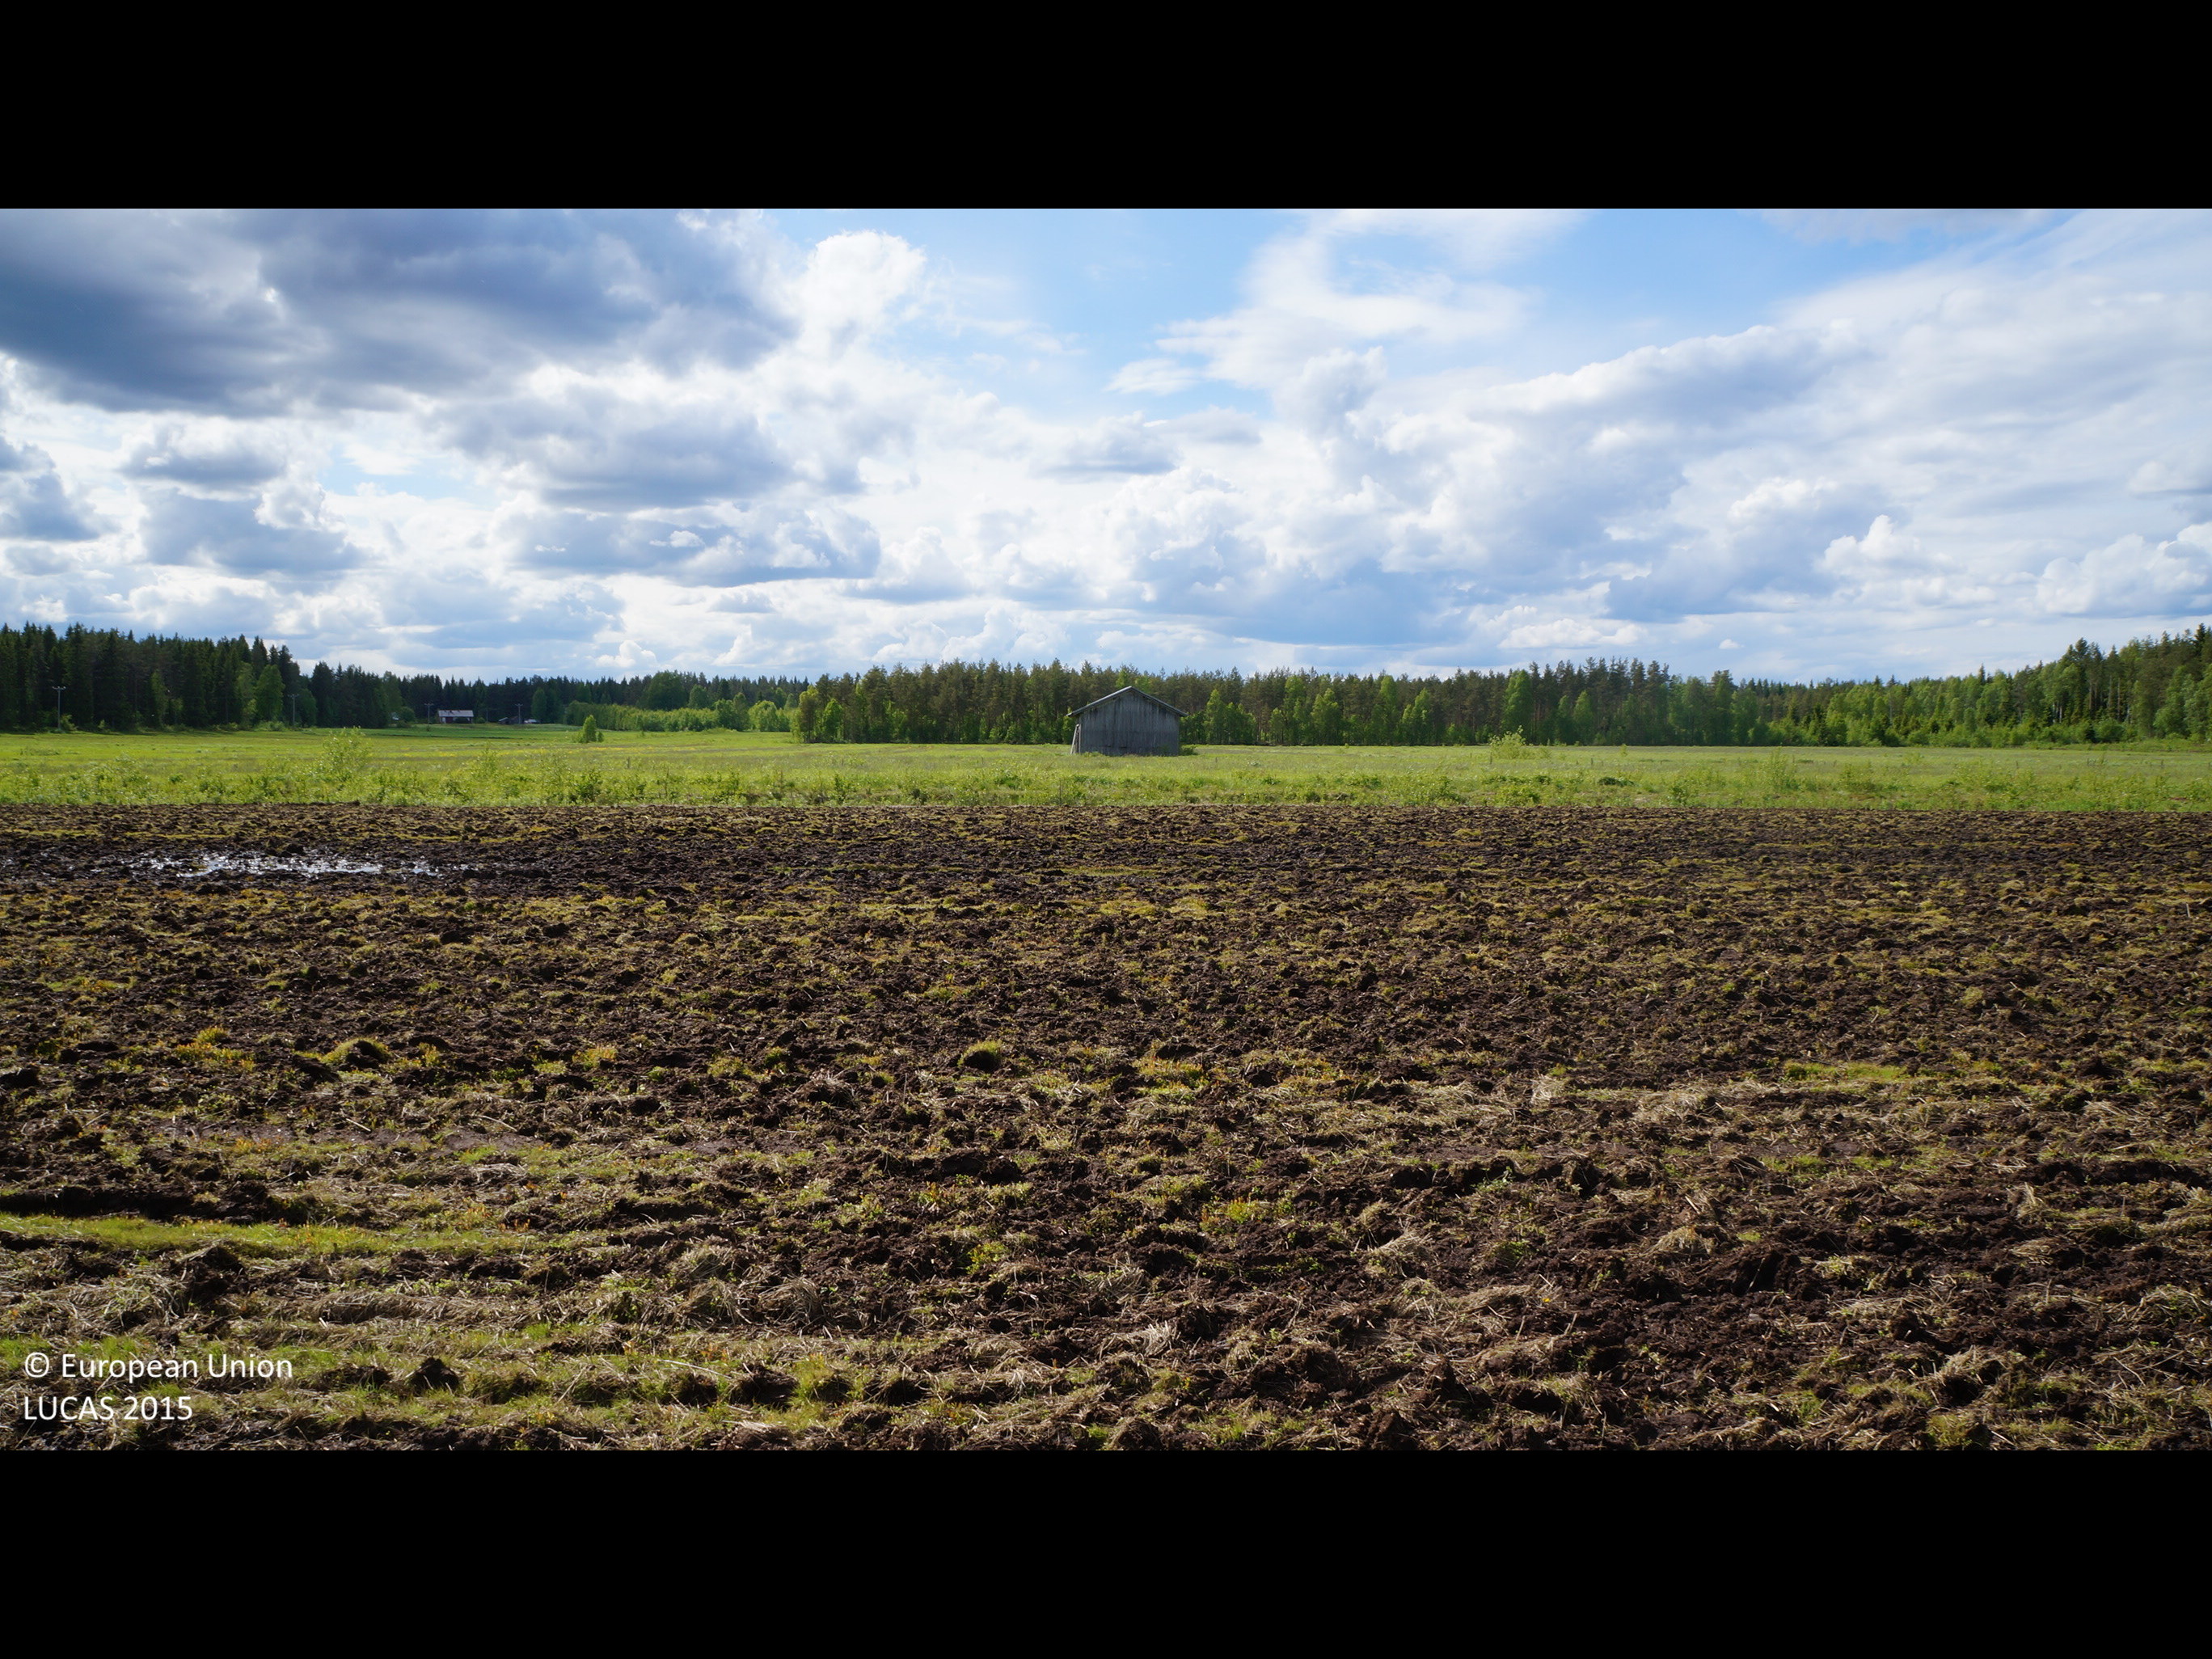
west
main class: Cropland
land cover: Temporary grasslands
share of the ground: > 75 %
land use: Agriculture (excluding fallow land and kitchen gardens)
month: June
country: FI
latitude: 64.0765
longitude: 25.2819
